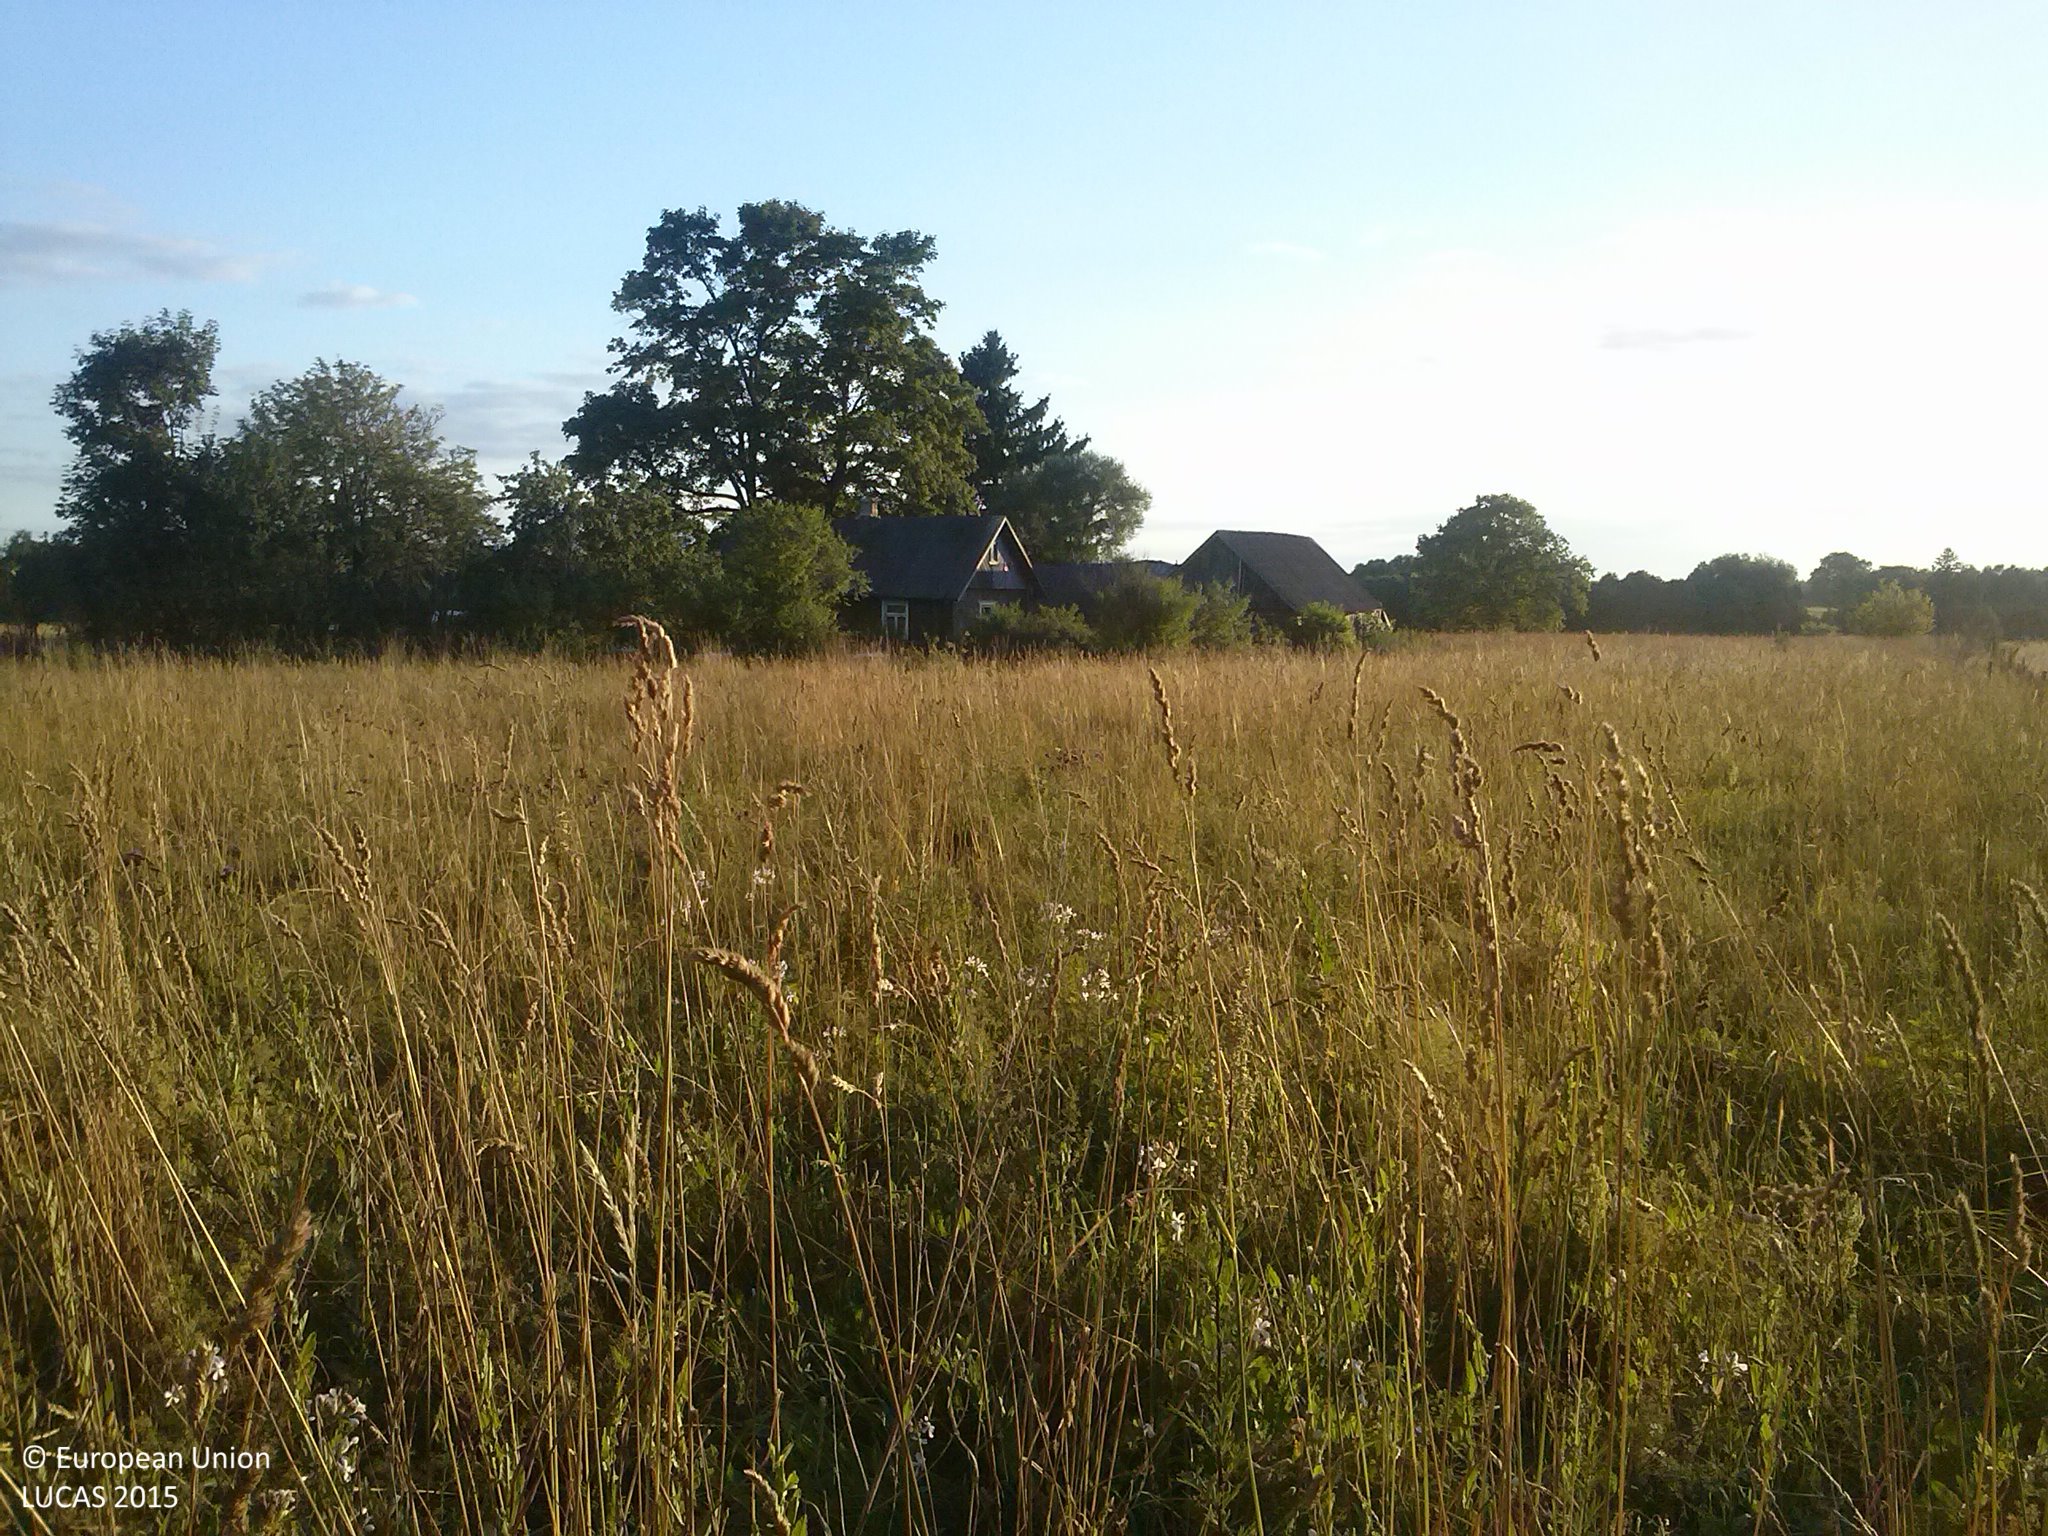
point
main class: Grassland
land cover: Grassland without tree/shrub cover
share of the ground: > 75 %
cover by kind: herbaceous plants 100 %
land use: Agriculture (excluding fallow land and kitchen gardens)
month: July
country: LV
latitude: 56.6168
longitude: 26.9283
